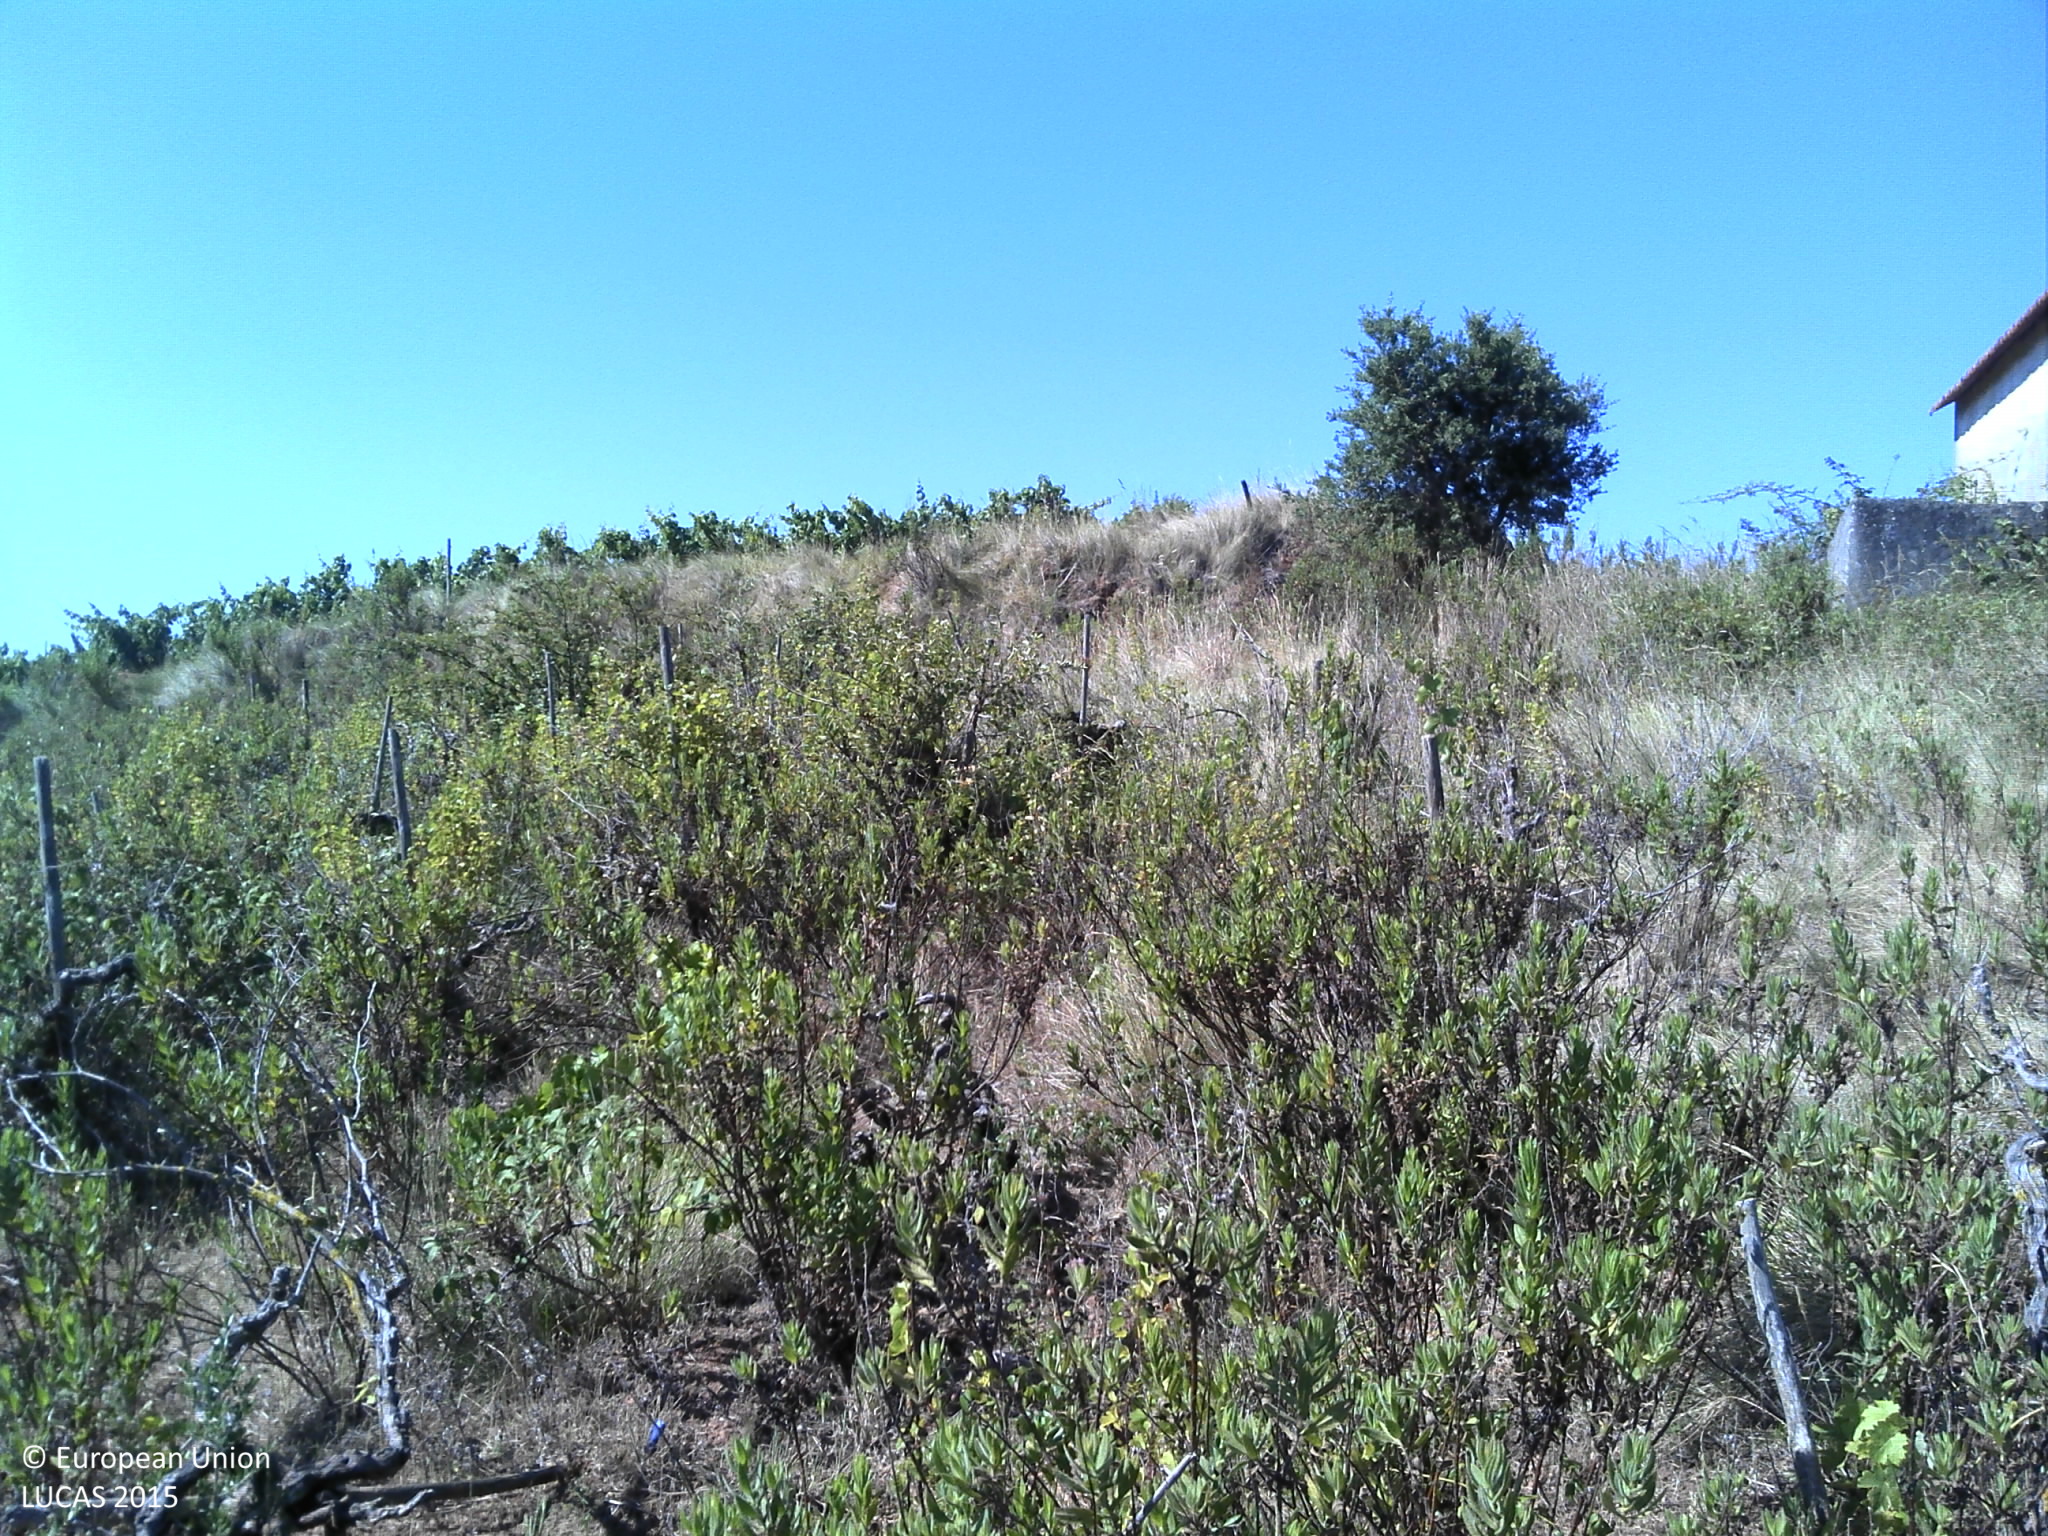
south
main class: Shrubland
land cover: Shrubland without tree cover
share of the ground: 50 - 75 %
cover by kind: shrubs 60 %, unconsolidated bare surface 30 %, herbaceous plants 10 %
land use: Semi-natural and natural areas not in use
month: June
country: PT
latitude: 39.0269
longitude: -9.2478
